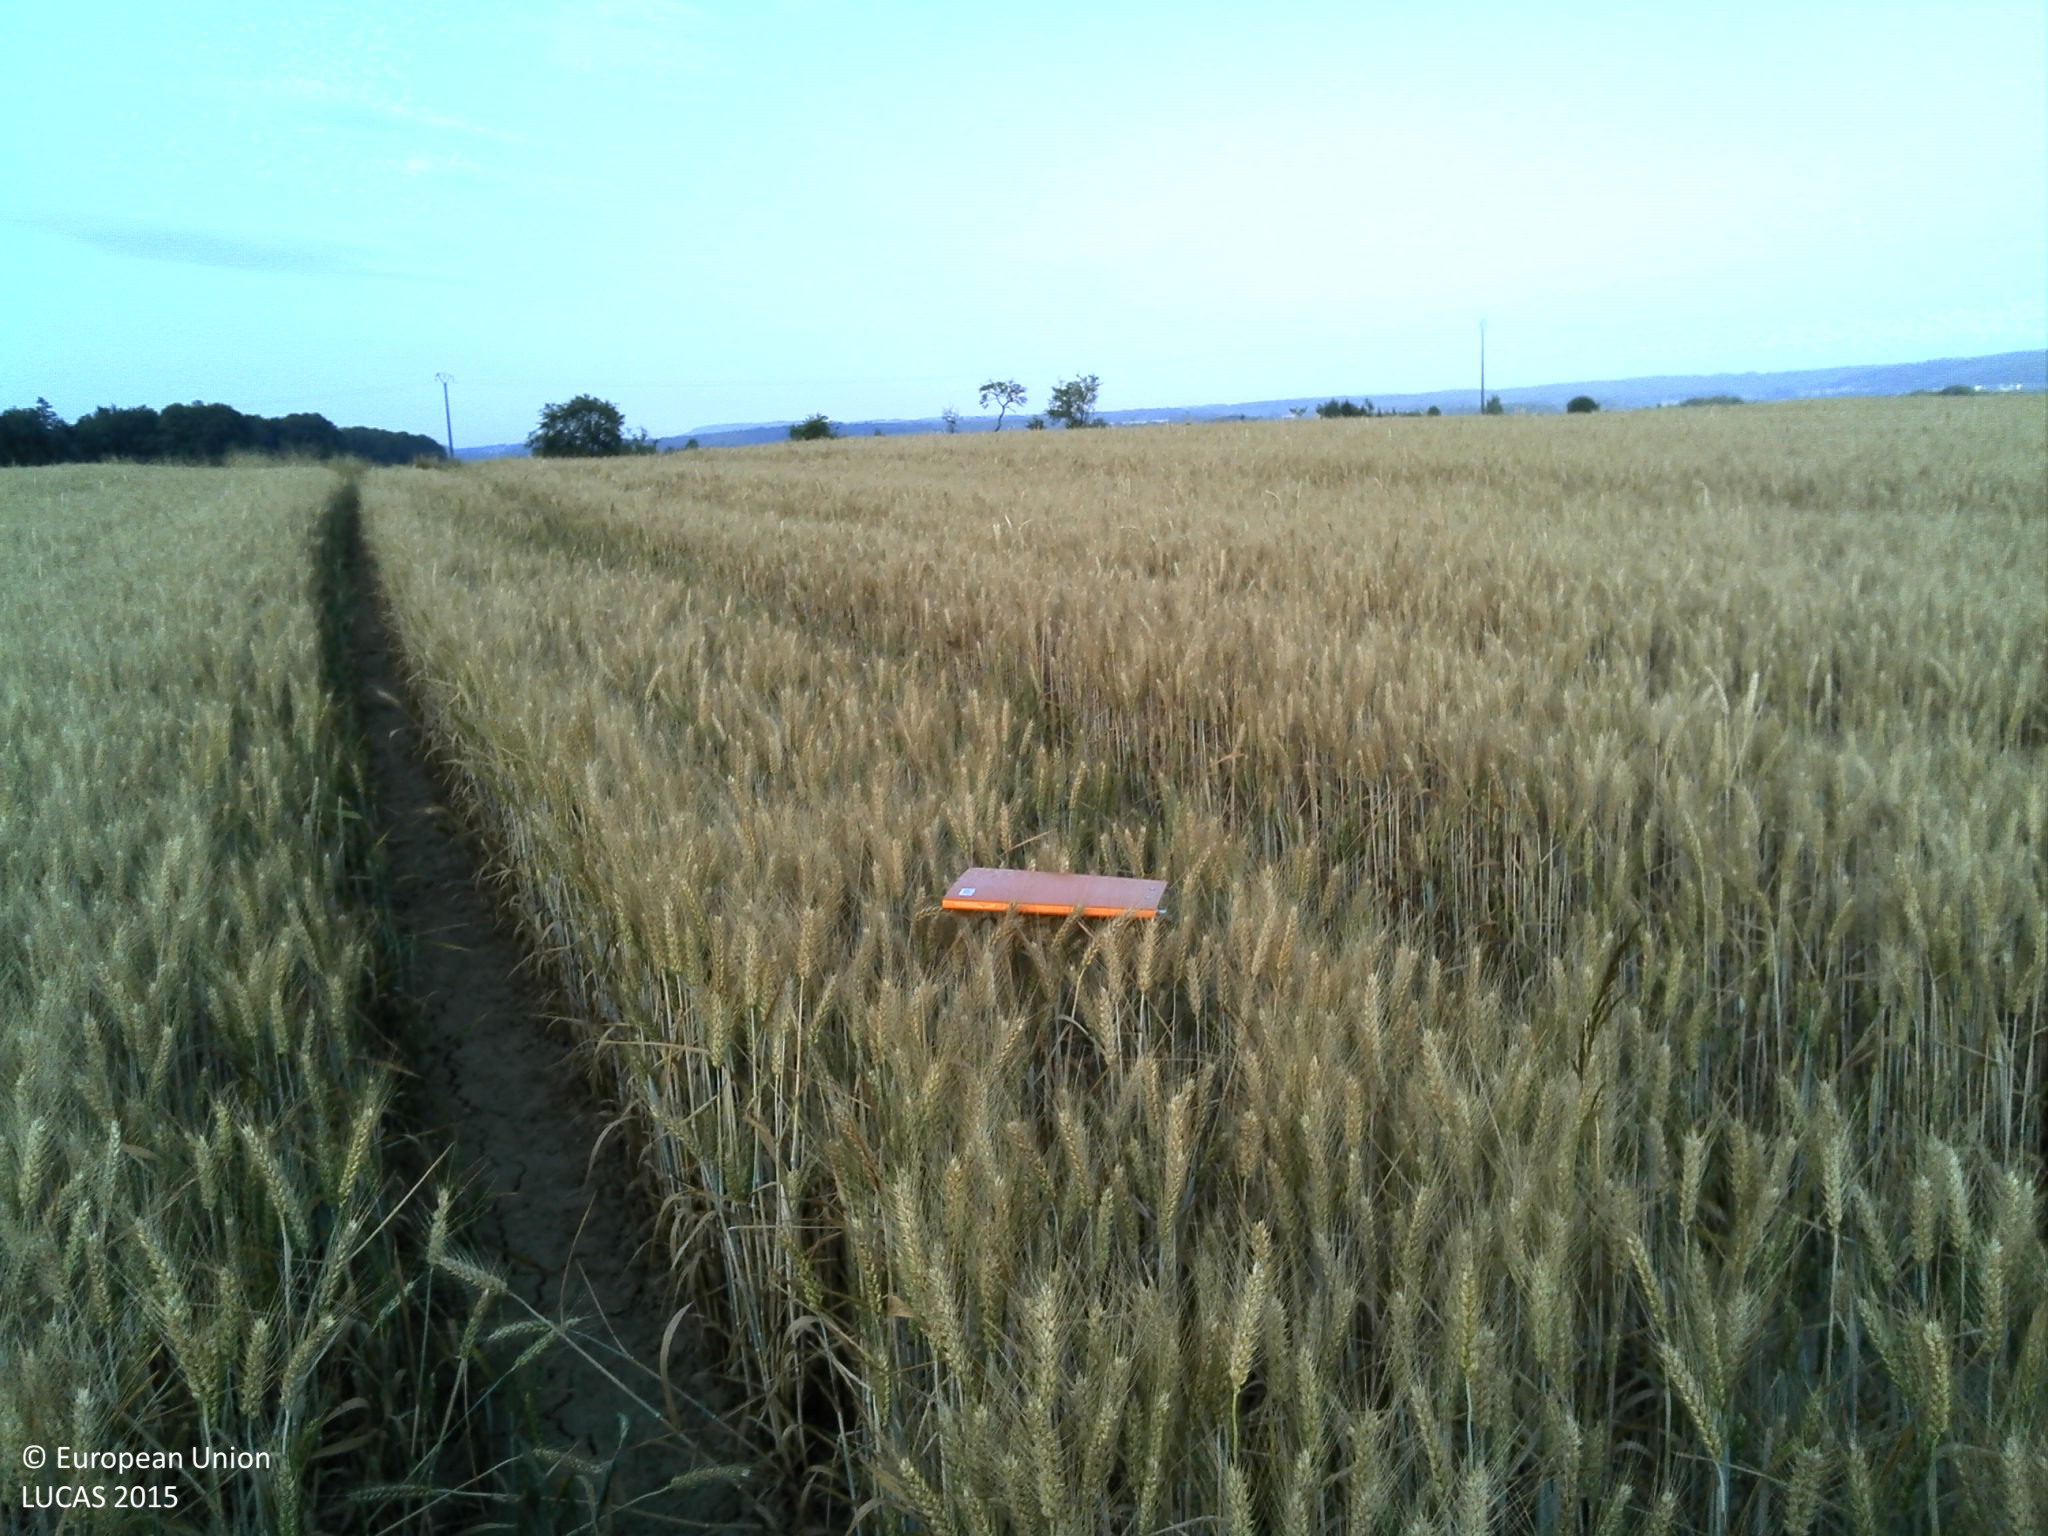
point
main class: Cropland
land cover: Durum wheat
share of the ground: > 75 %
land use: Agriculture (excluding fallow land and kitchen gardens)
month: July
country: FR
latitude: 48.1086
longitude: 6.3341
